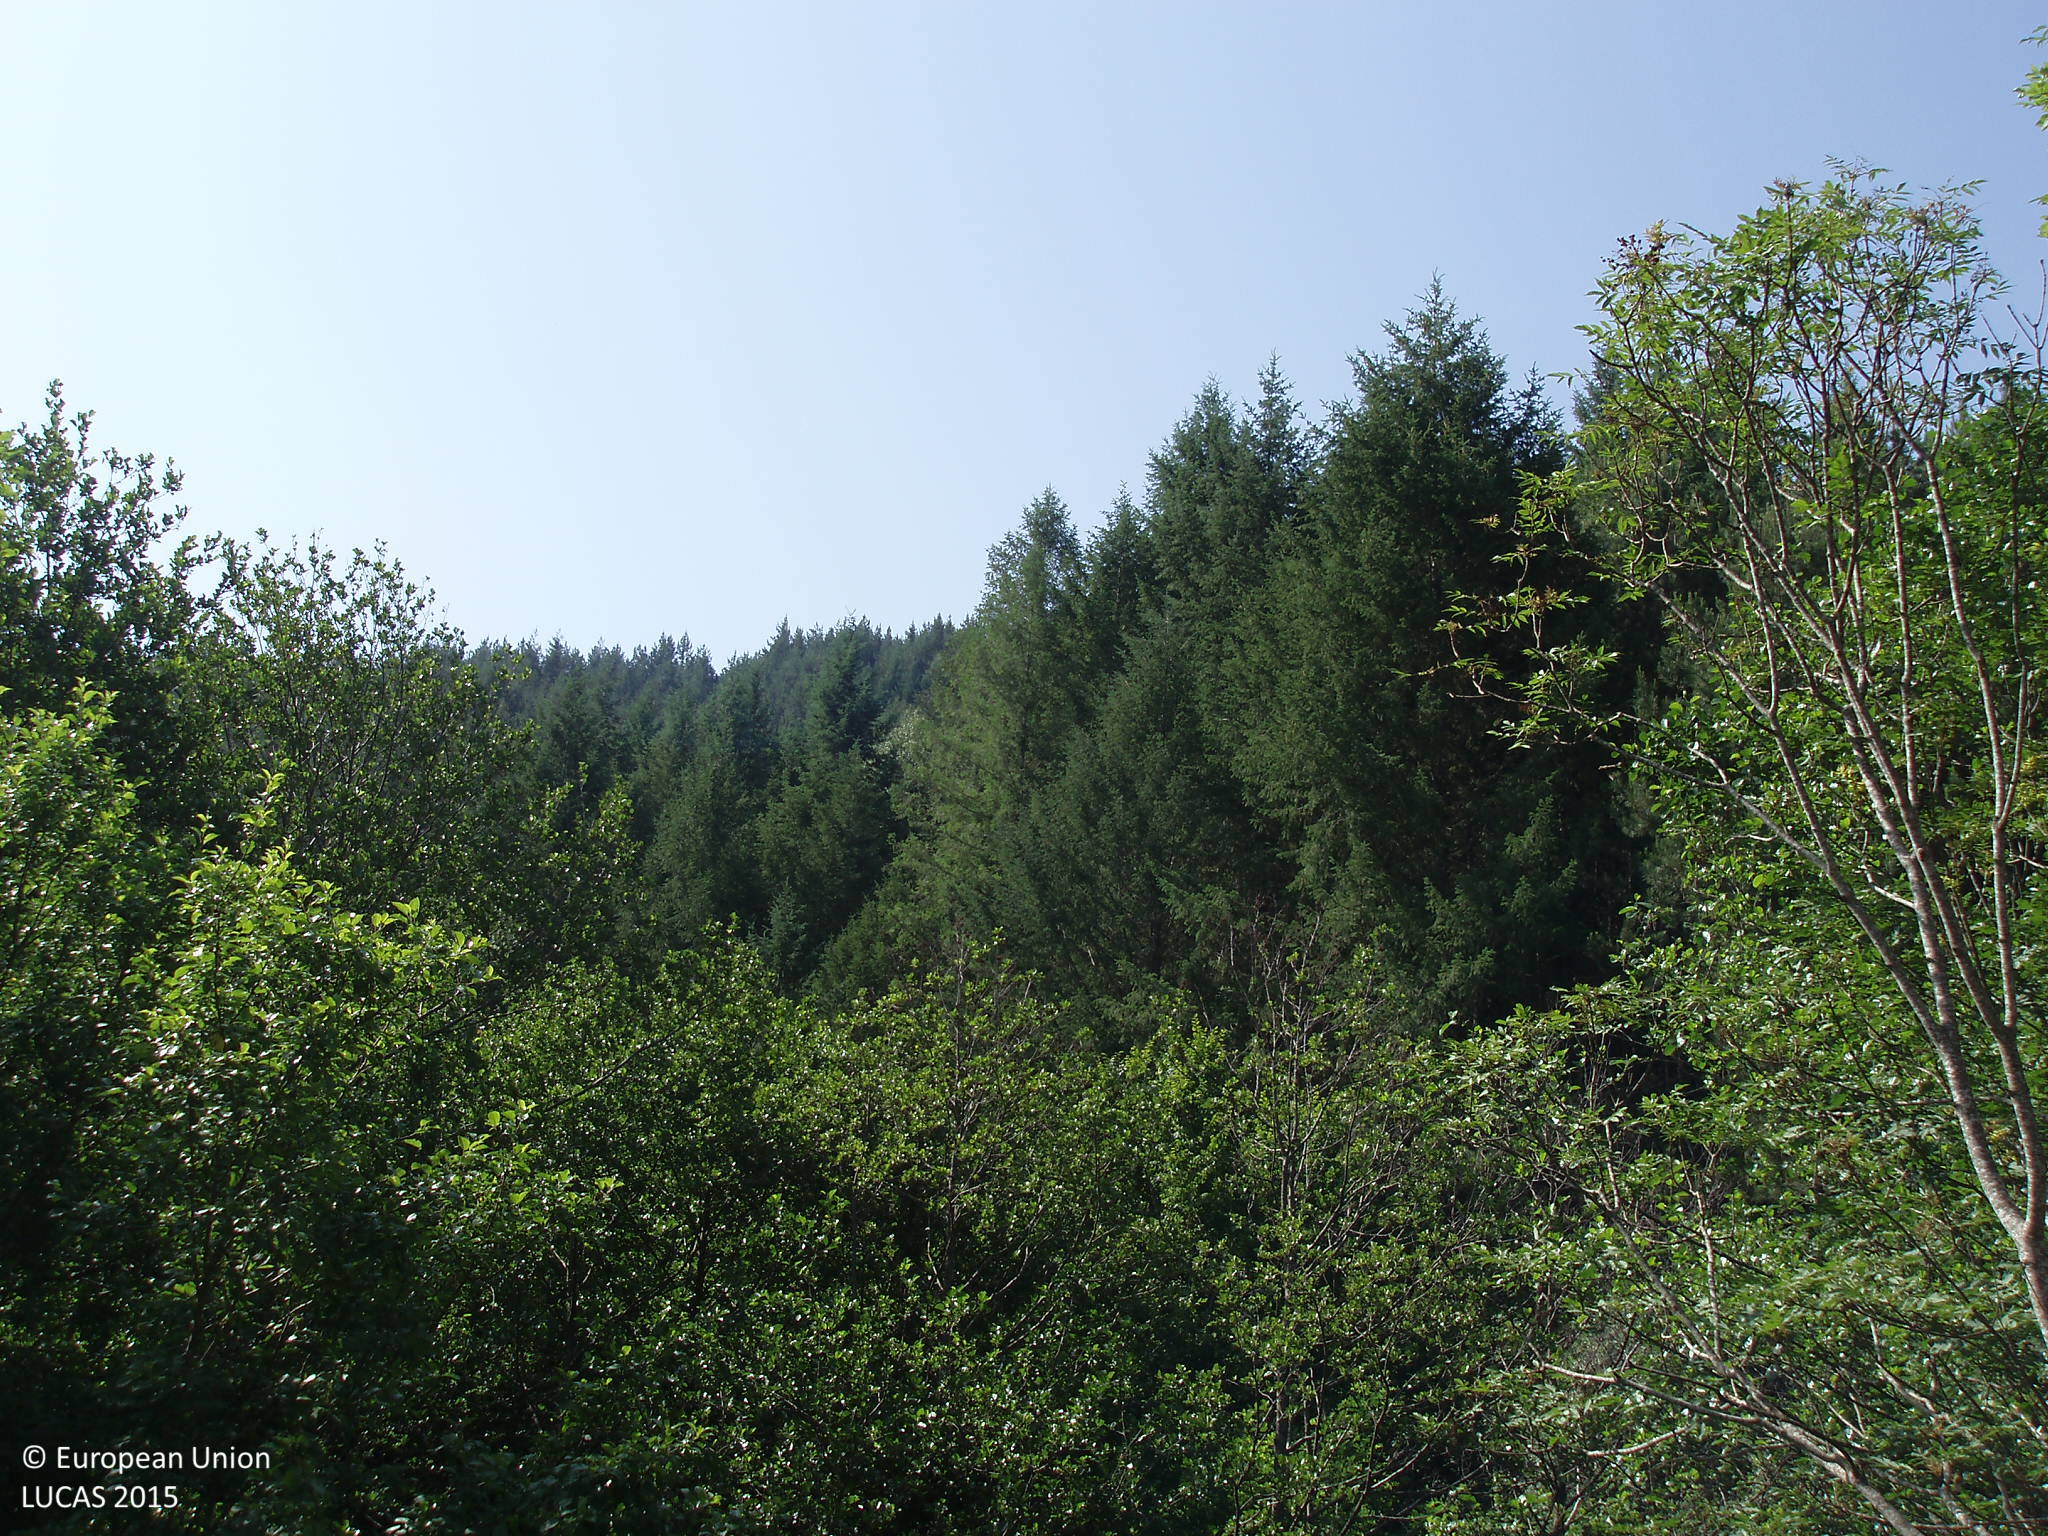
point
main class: Woodland
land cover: Pine dominated mixed woodland
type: hemiboreal forest and nemoral coniferous forest and mixed broadleaved-coniferous forest
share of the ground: > 75 %
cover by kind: coniferous forest trees 75 %, broadleaved forest trees 25 %
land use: Forestry
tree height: > 5 m
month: June
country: BG
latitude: 41.4605
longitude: 23.7109
